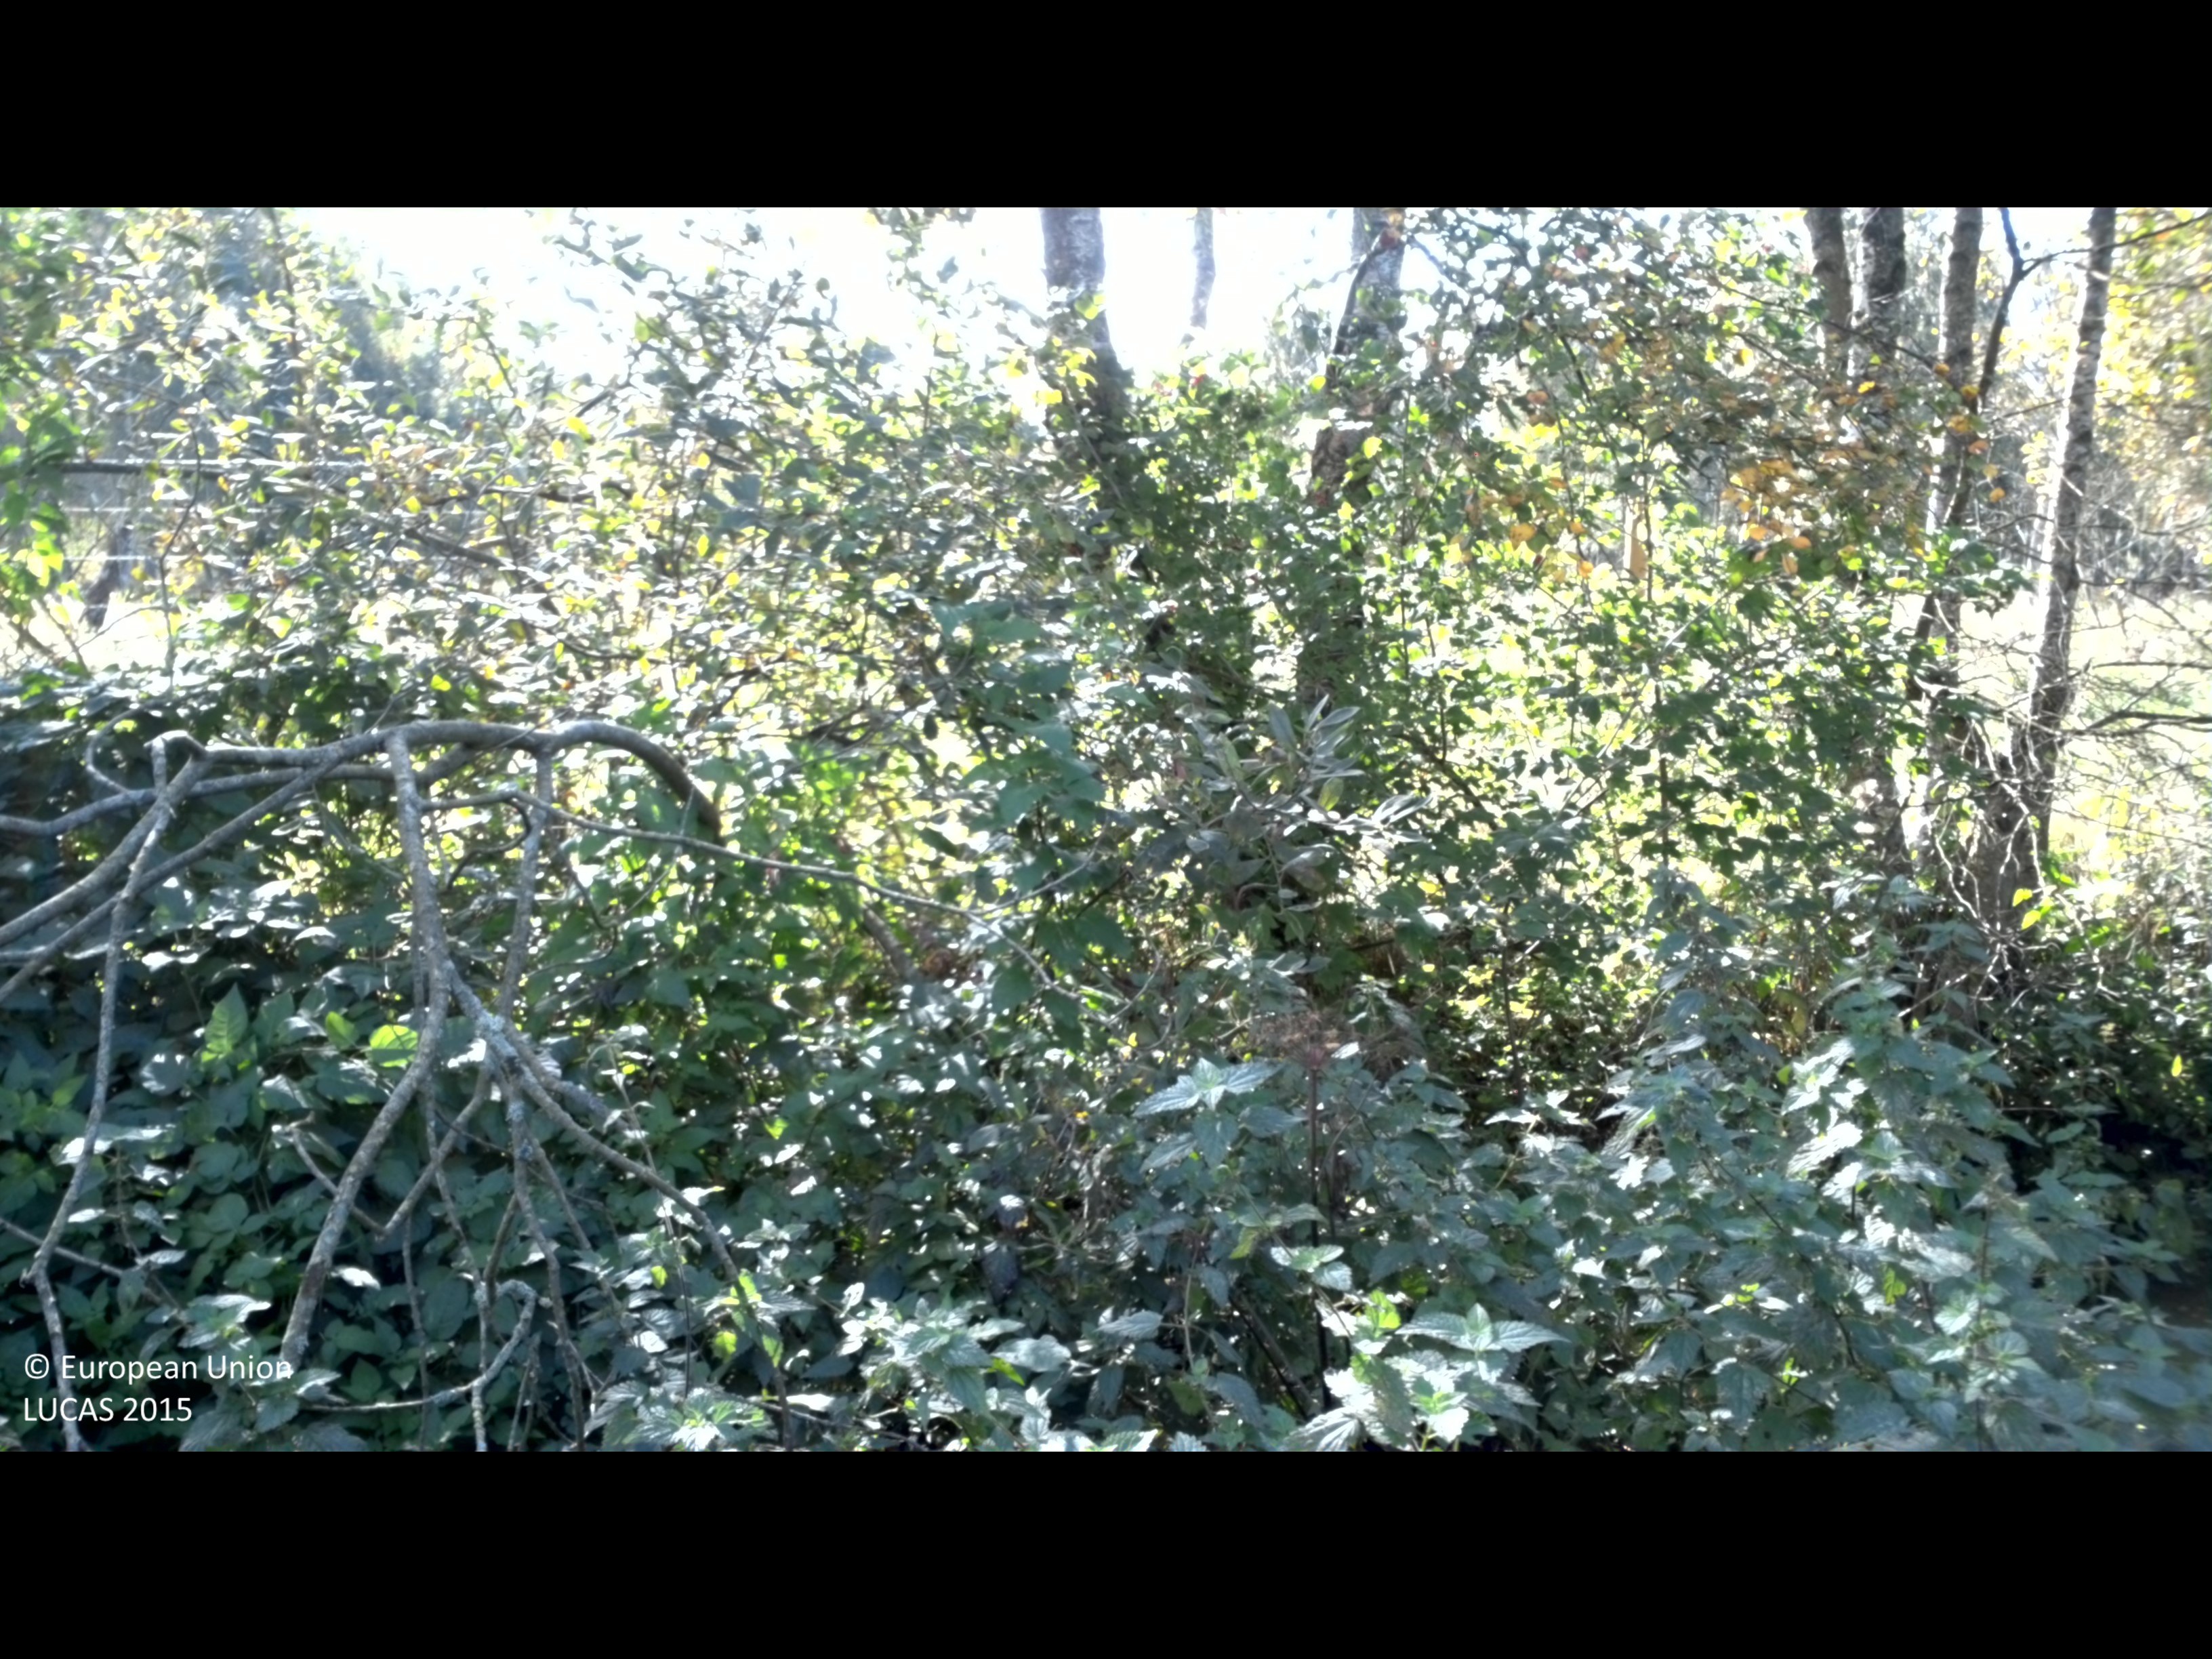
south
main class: Woodland
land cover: Broadleaved woodland
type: hemiboreal forest and nemoral coniferous forest and mixed broadleaved-coniferous forest
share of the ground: > 75 %
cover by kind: broadleaved forest trees 75 %, herbaceous plants 25 %
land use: Forestry
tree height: < 5 m
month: September
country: SE
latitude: 56.0242
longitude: 14.3462
